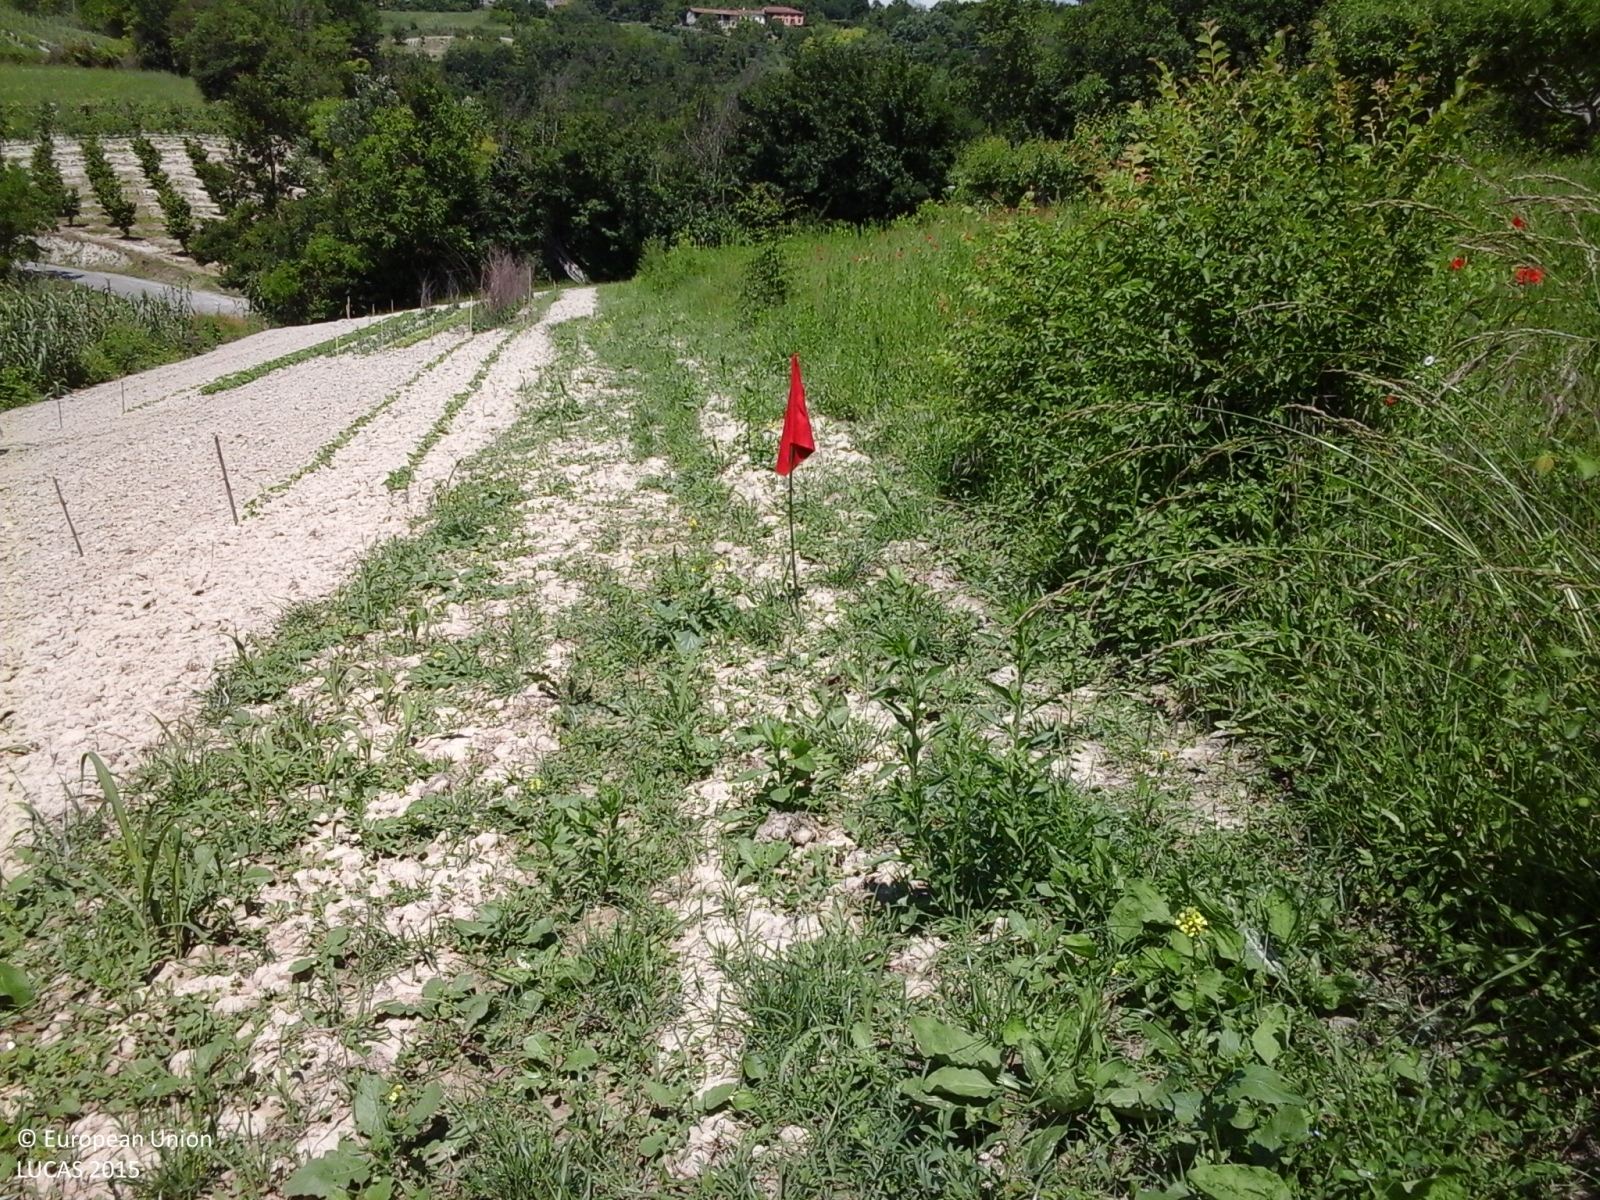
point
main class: Grassland
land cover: Spontaneously vegetated surfaces
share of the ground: > 75 %
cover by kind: herbaceous plants 70 %, unconsolidated bare surface 30 %
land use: Agriculture (excluding fallow land and kitchen gardens)
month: May
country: IT
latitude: 45.1471
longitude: 8.2353
